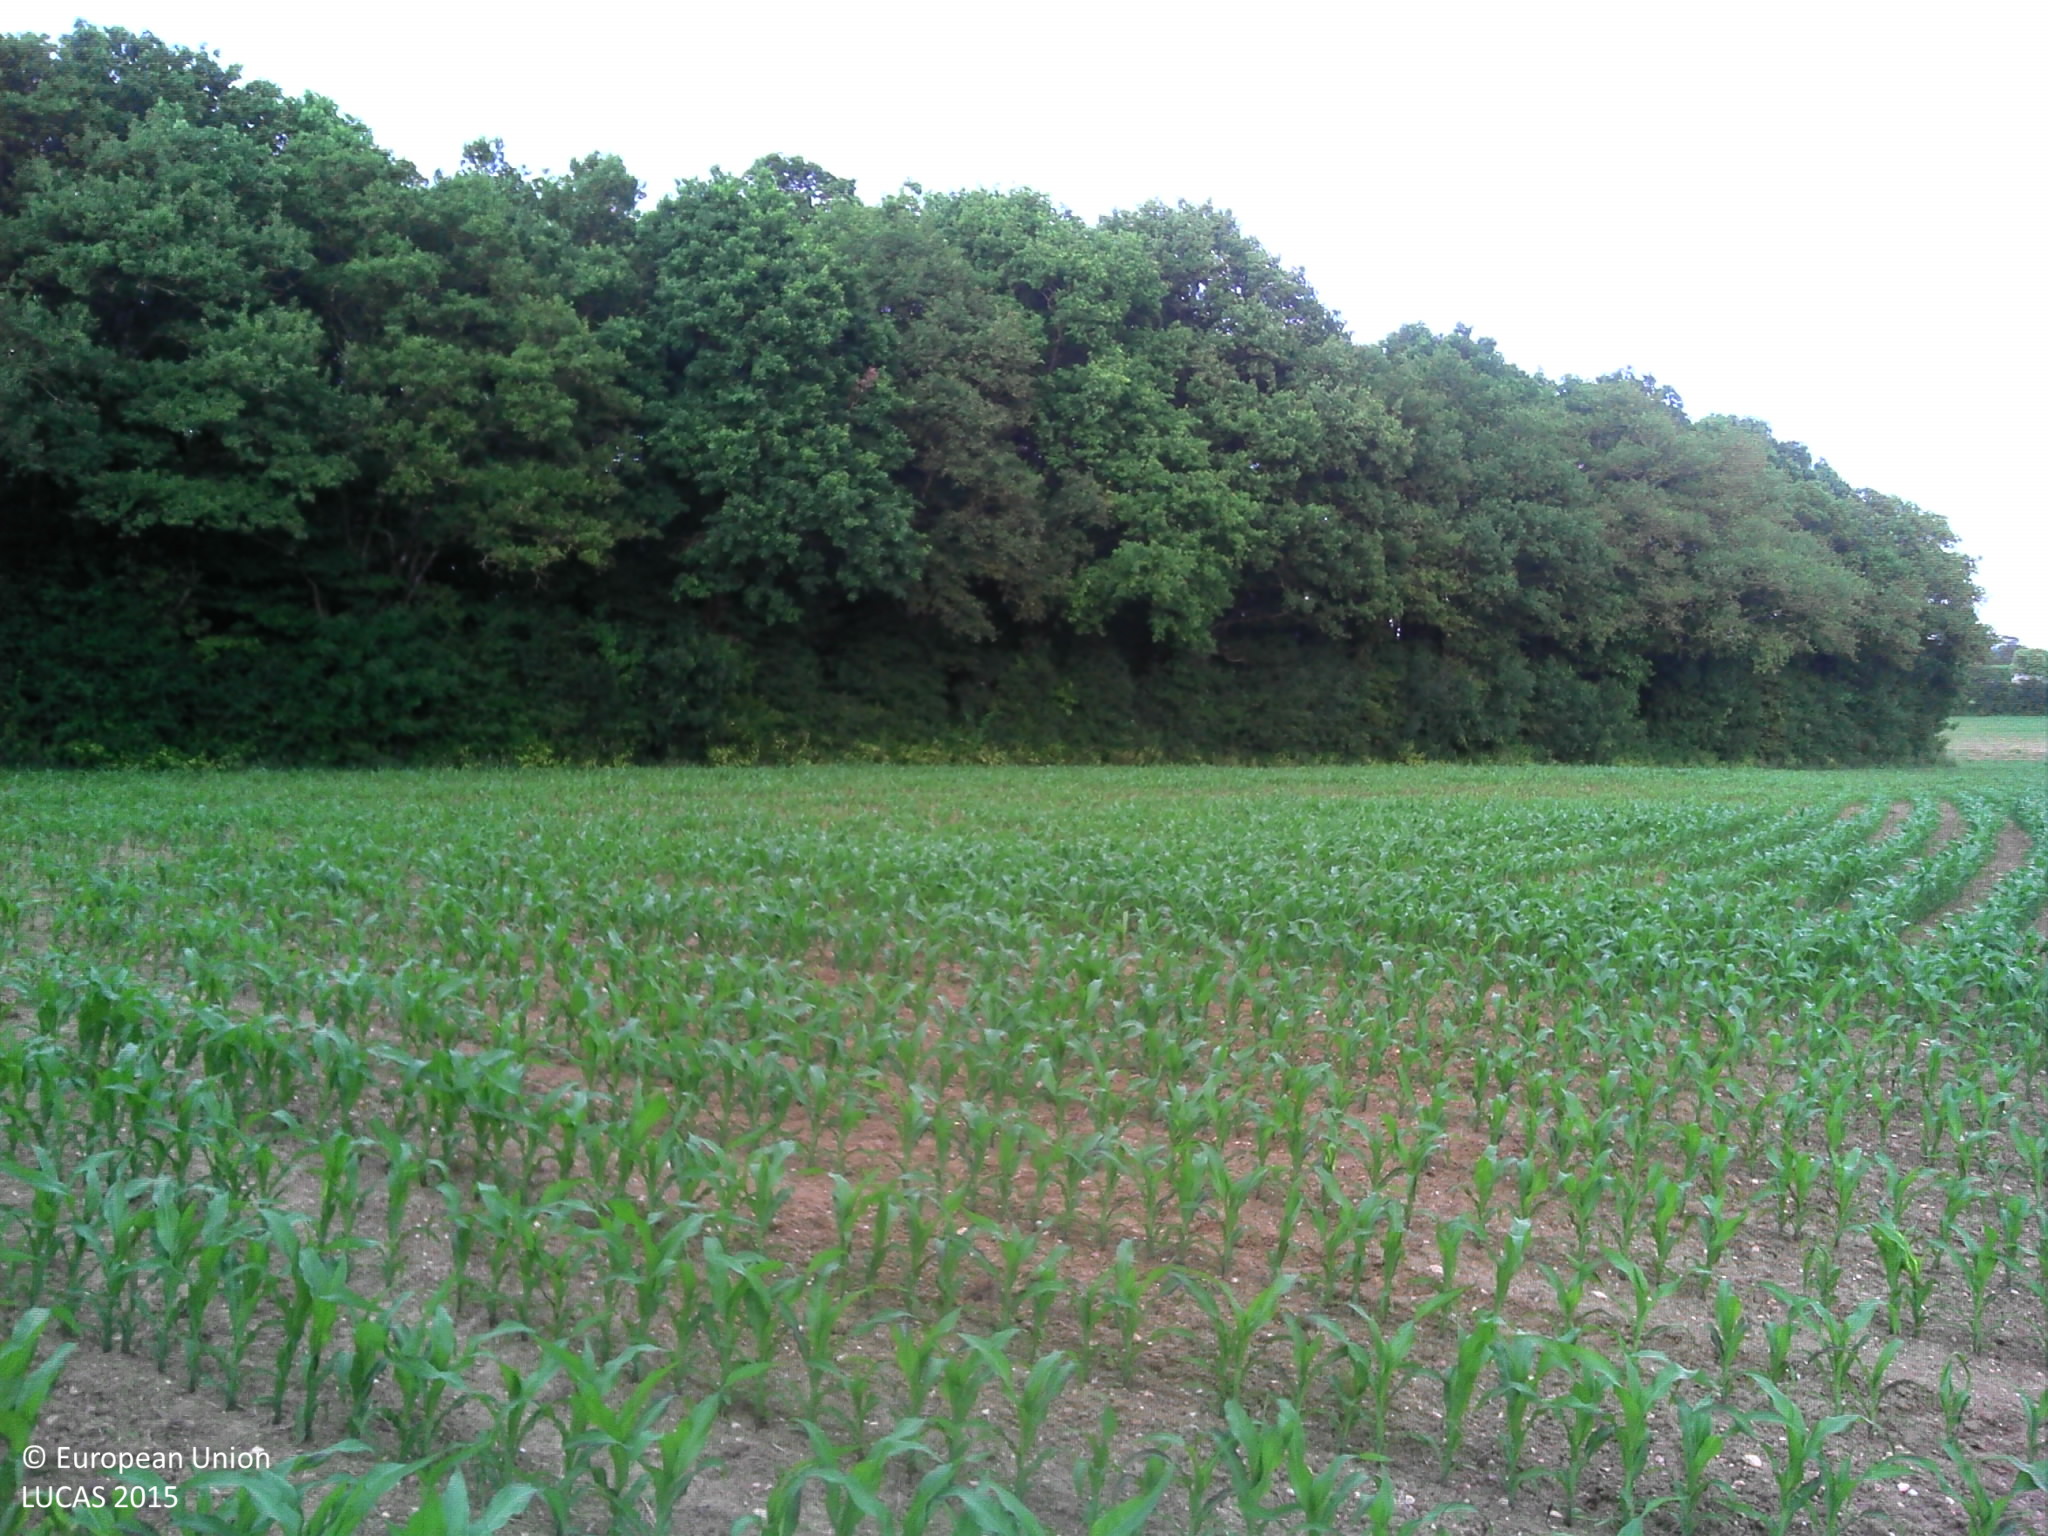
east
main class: Cropland
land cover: Maize
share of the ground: 25 - 50 %
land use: Agriculture (excluding fallow land and kitchen gardens)
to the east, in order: Maize; Broadleaved woodland; Ponds and wetlands; Spontaneously vegetated surfaces; Common wheat; Ditches and canals; Abandoned hedges; Fences; Grassland without tree/shrub cover; Ditches and canals; Grassland without tree/shrub cover
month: June
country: FR
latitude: 46.8113
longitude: -1.7455
